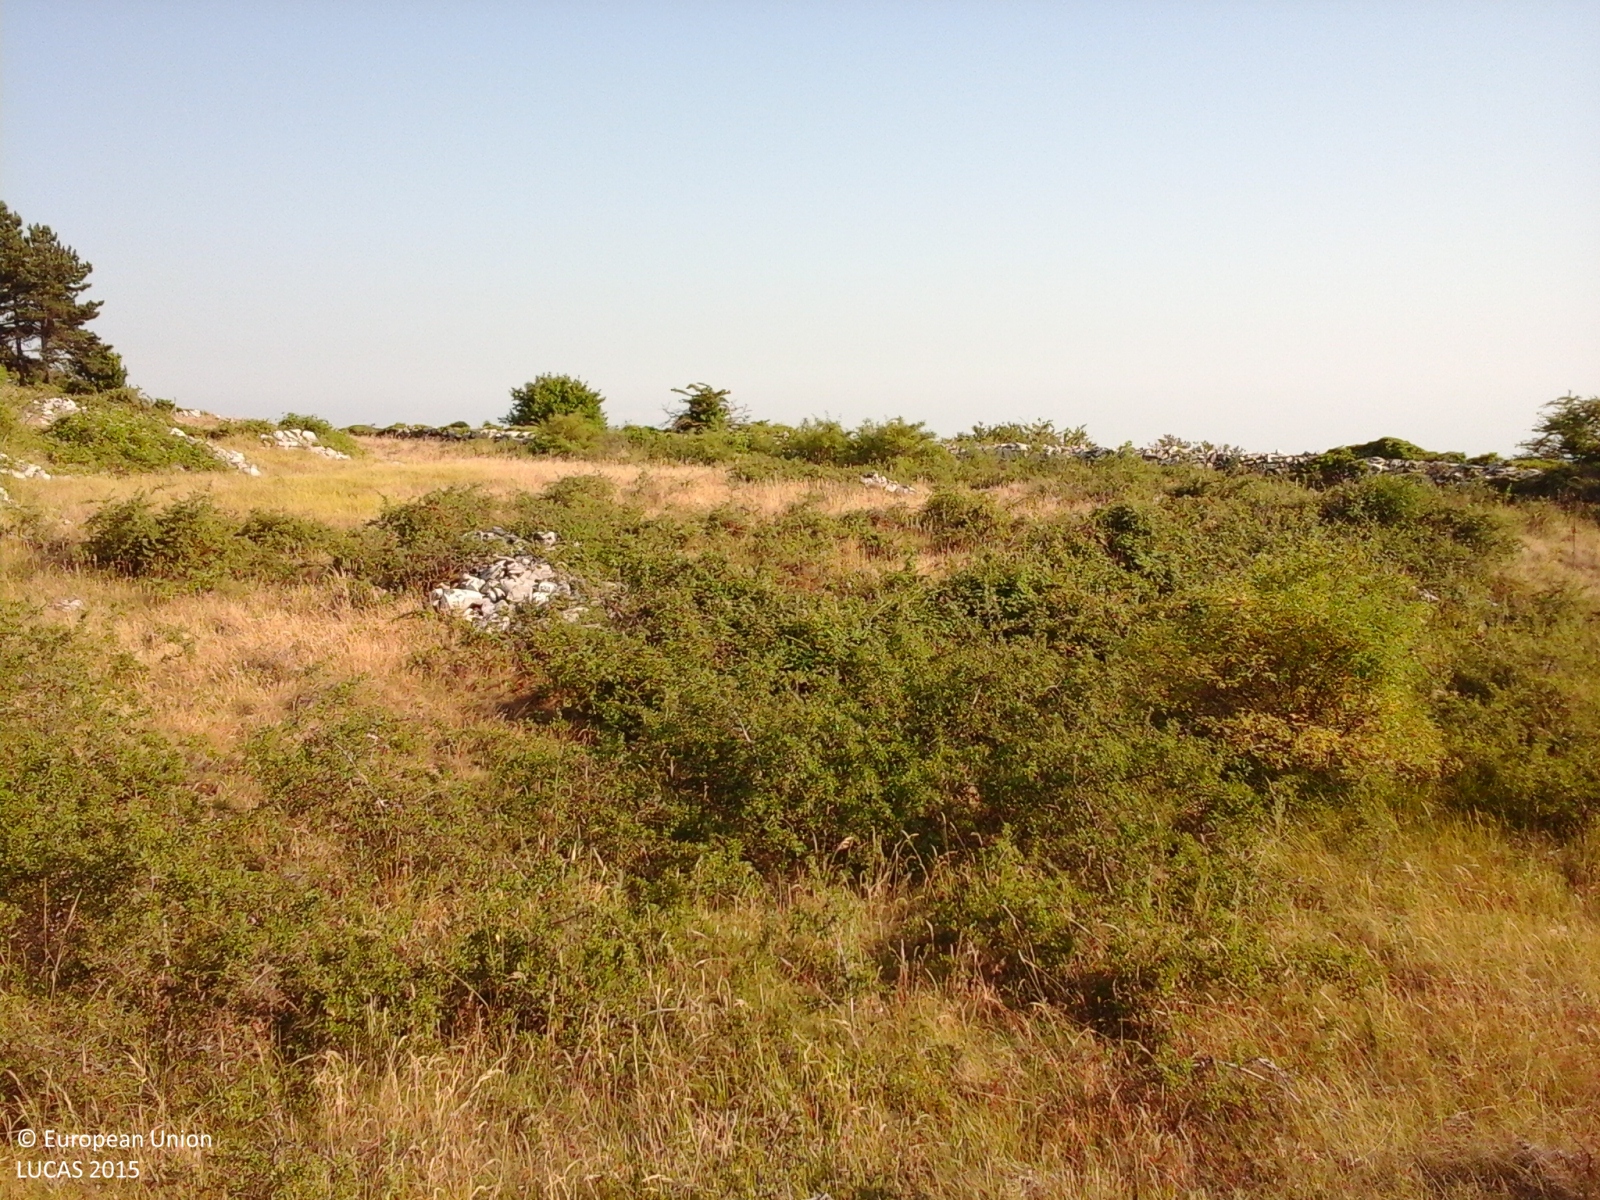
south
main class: Shrubland
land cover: Shrubland with sparse tree cover
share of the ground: > 75 %
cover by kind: shrubs 60 %, herbaceous plants 35 %, broadleaved forest trees 5 %
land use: Semi-natural and natural areas not in use
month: July
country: IT
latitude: 41.4574
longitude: 14.7360
